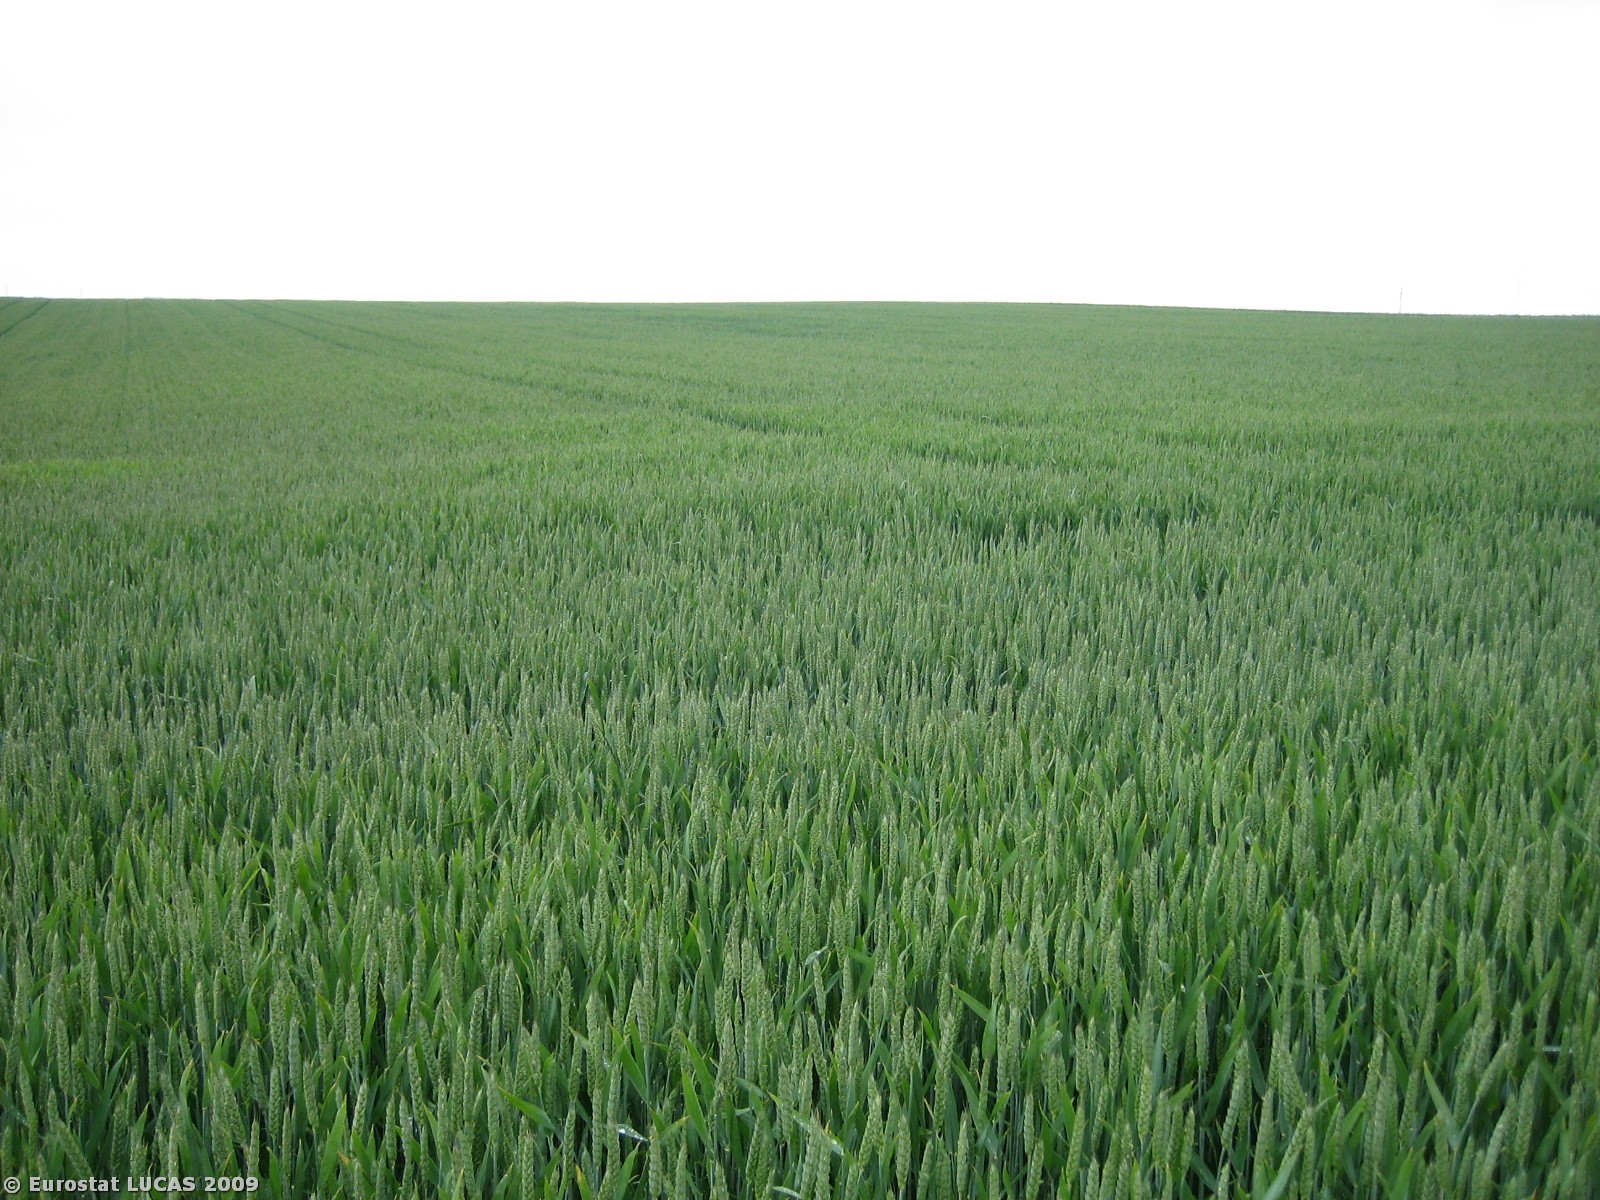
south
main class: Cropland
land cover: Common wheat
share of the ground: > 75 %
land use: Agriculture (excluding fallow land and kitchen gardens)
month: June
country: DK
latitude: 56.1518
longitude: 10.0161
